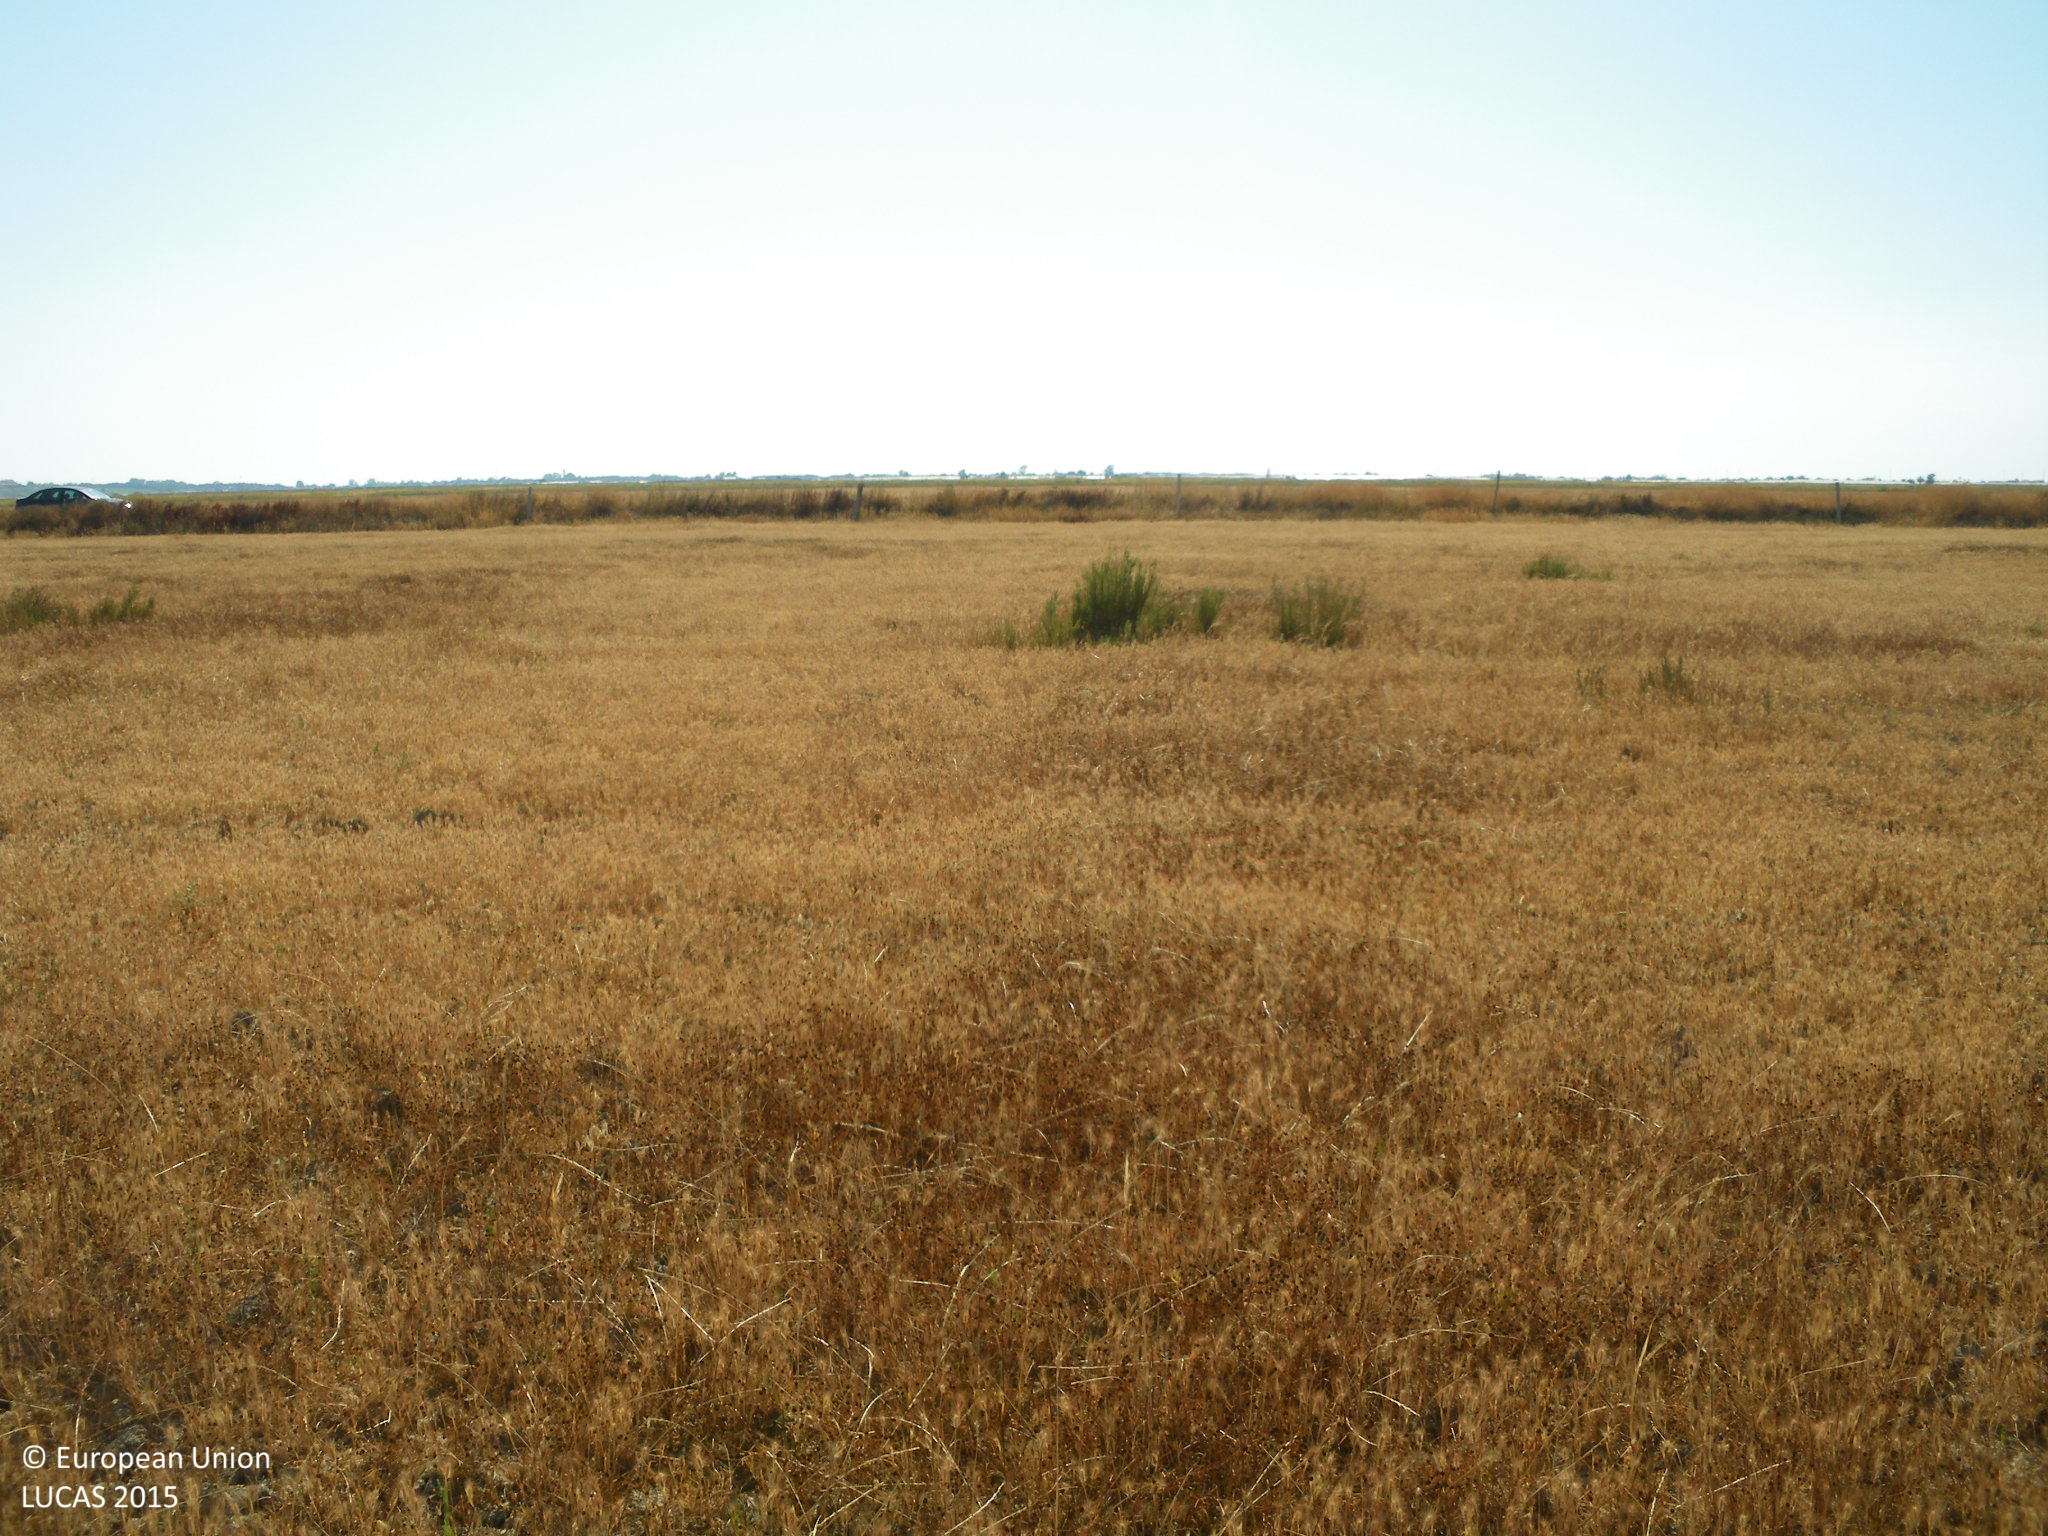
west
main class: Grassland
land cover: Spontaneously vegetated surfaces
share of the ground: > 75 %
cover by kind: herbaceous plants 100 %
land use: Agriculture (excluding fallow land and kitchen gardens)
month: May
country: ES
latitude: 36.8138
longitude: -6.2825
